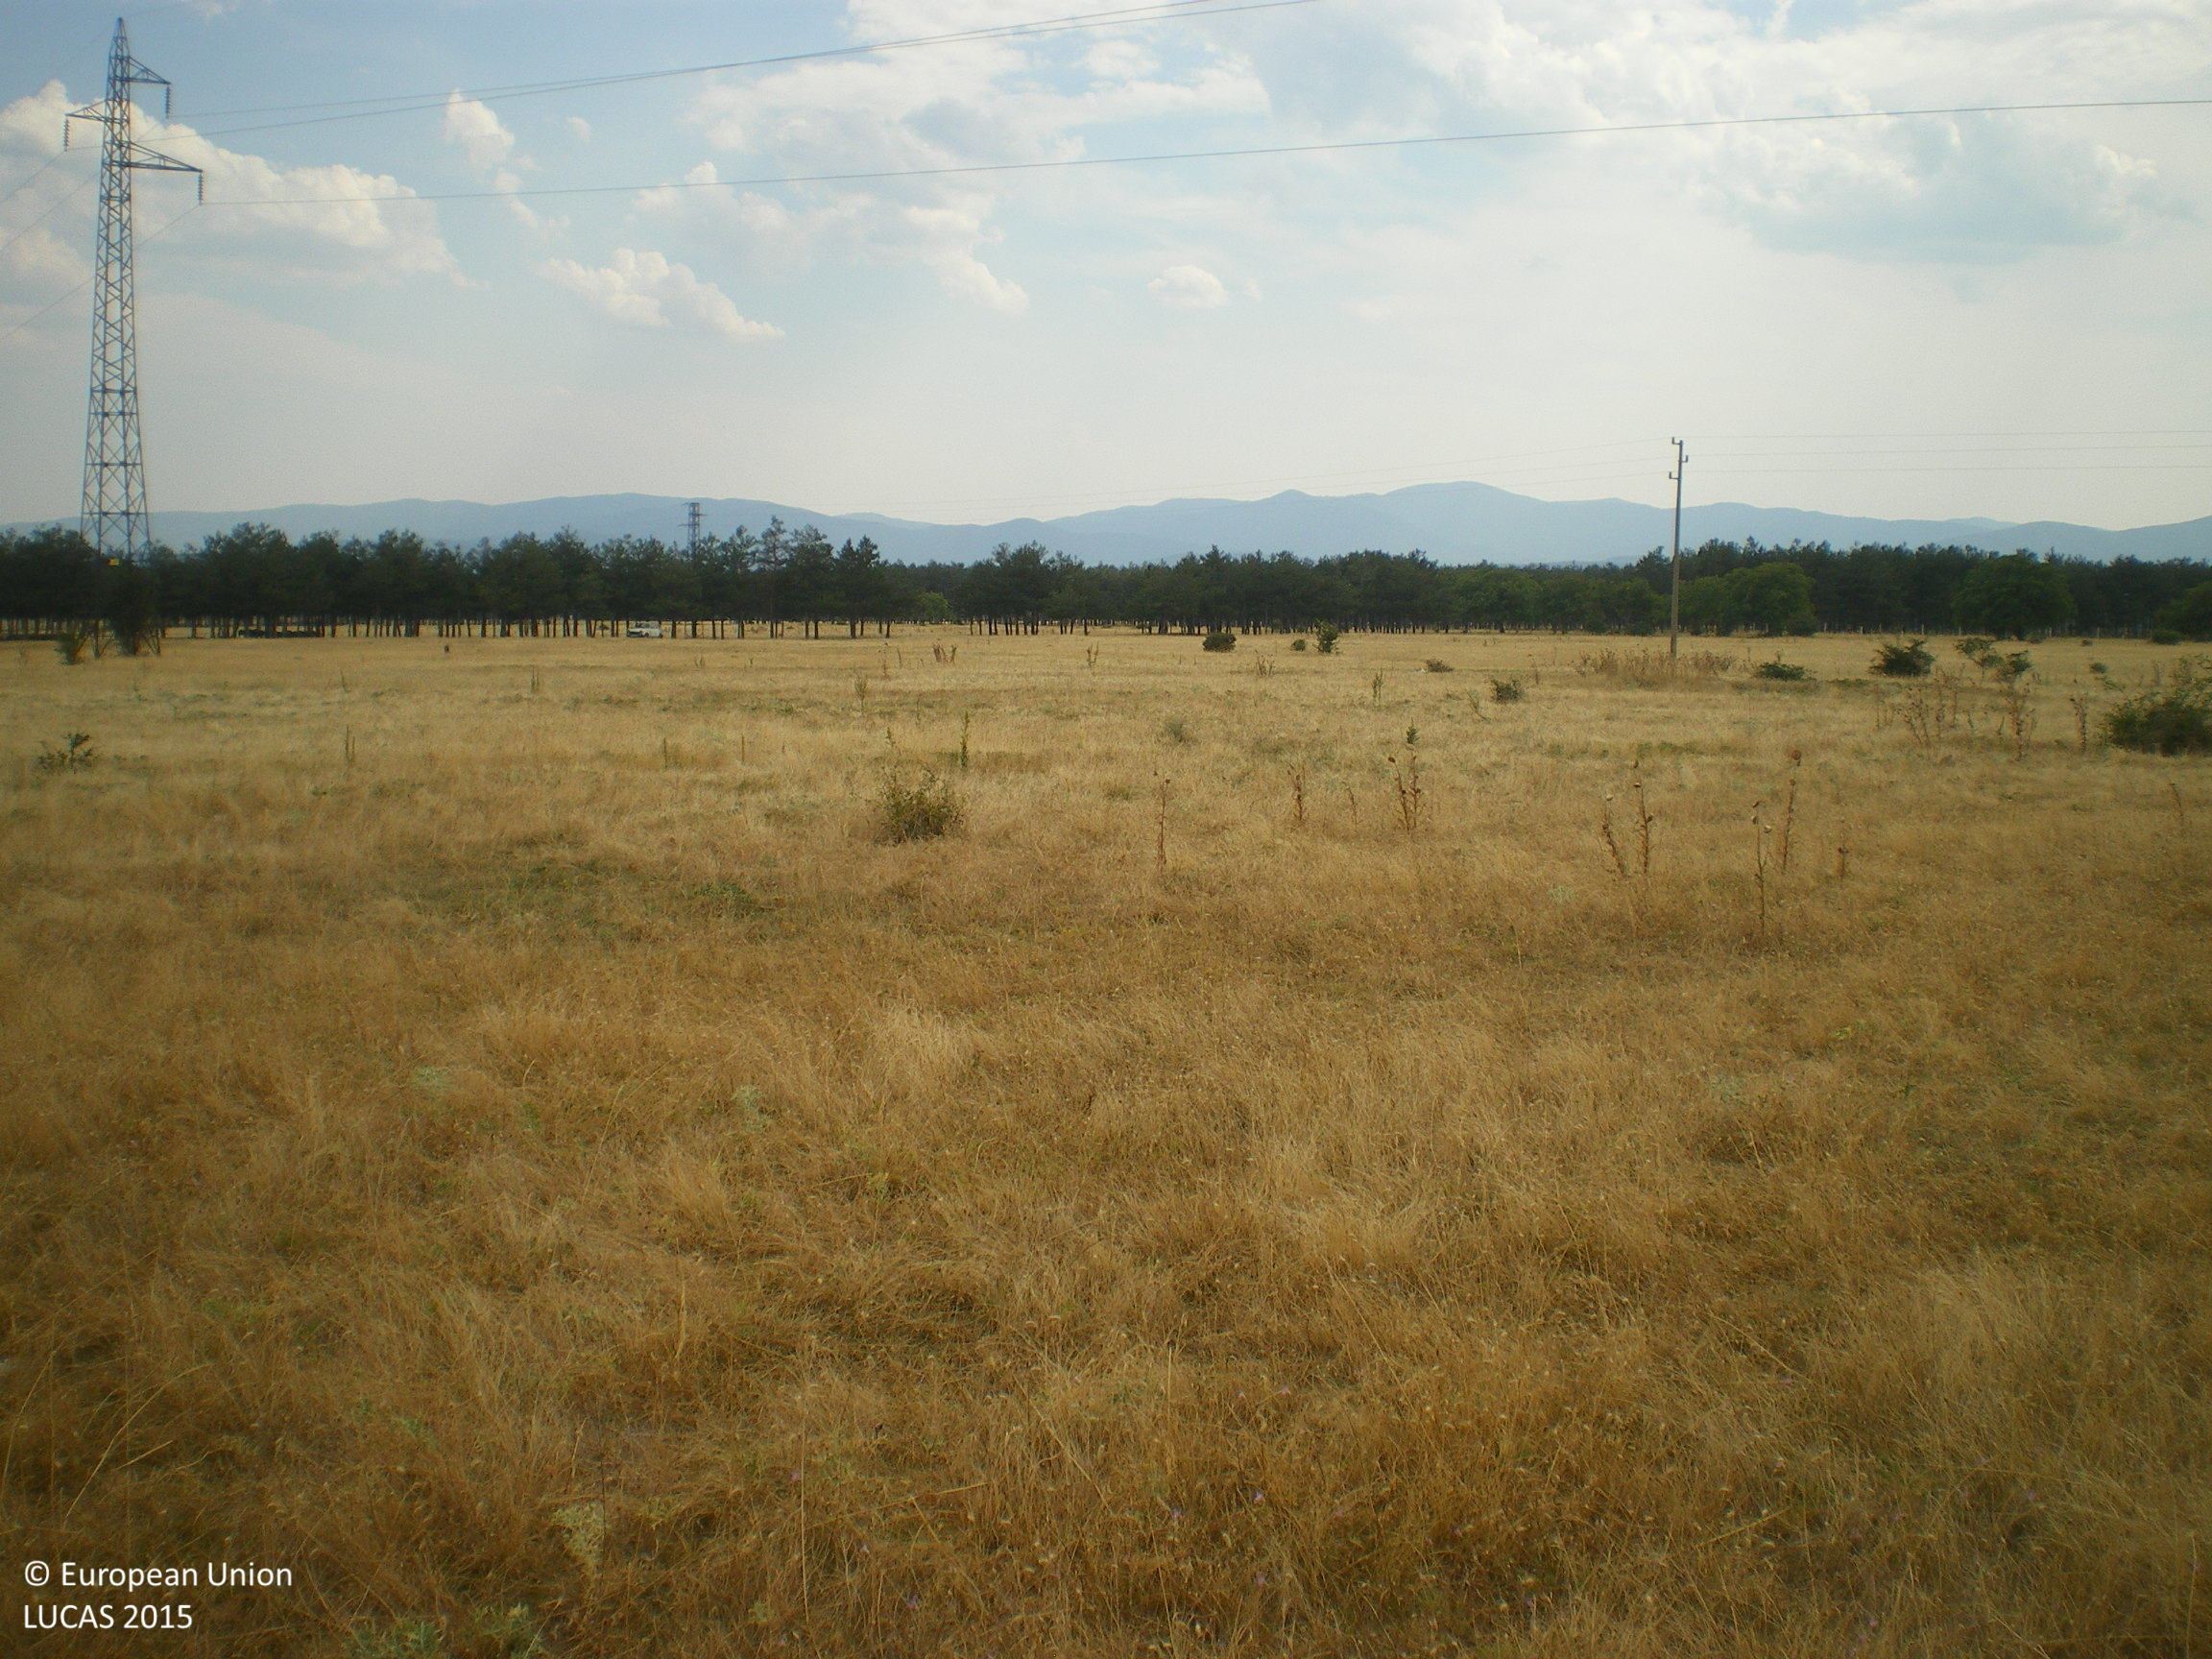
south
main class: Grassland
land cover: Grassland without tree/shrub cover
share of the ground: > 75 %
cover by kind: herbaceous plants 100 %
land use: Agriculture (excluding fallow land and kitchen gardens)
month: July
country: BG
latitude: 42.6716
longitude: 25.2089
